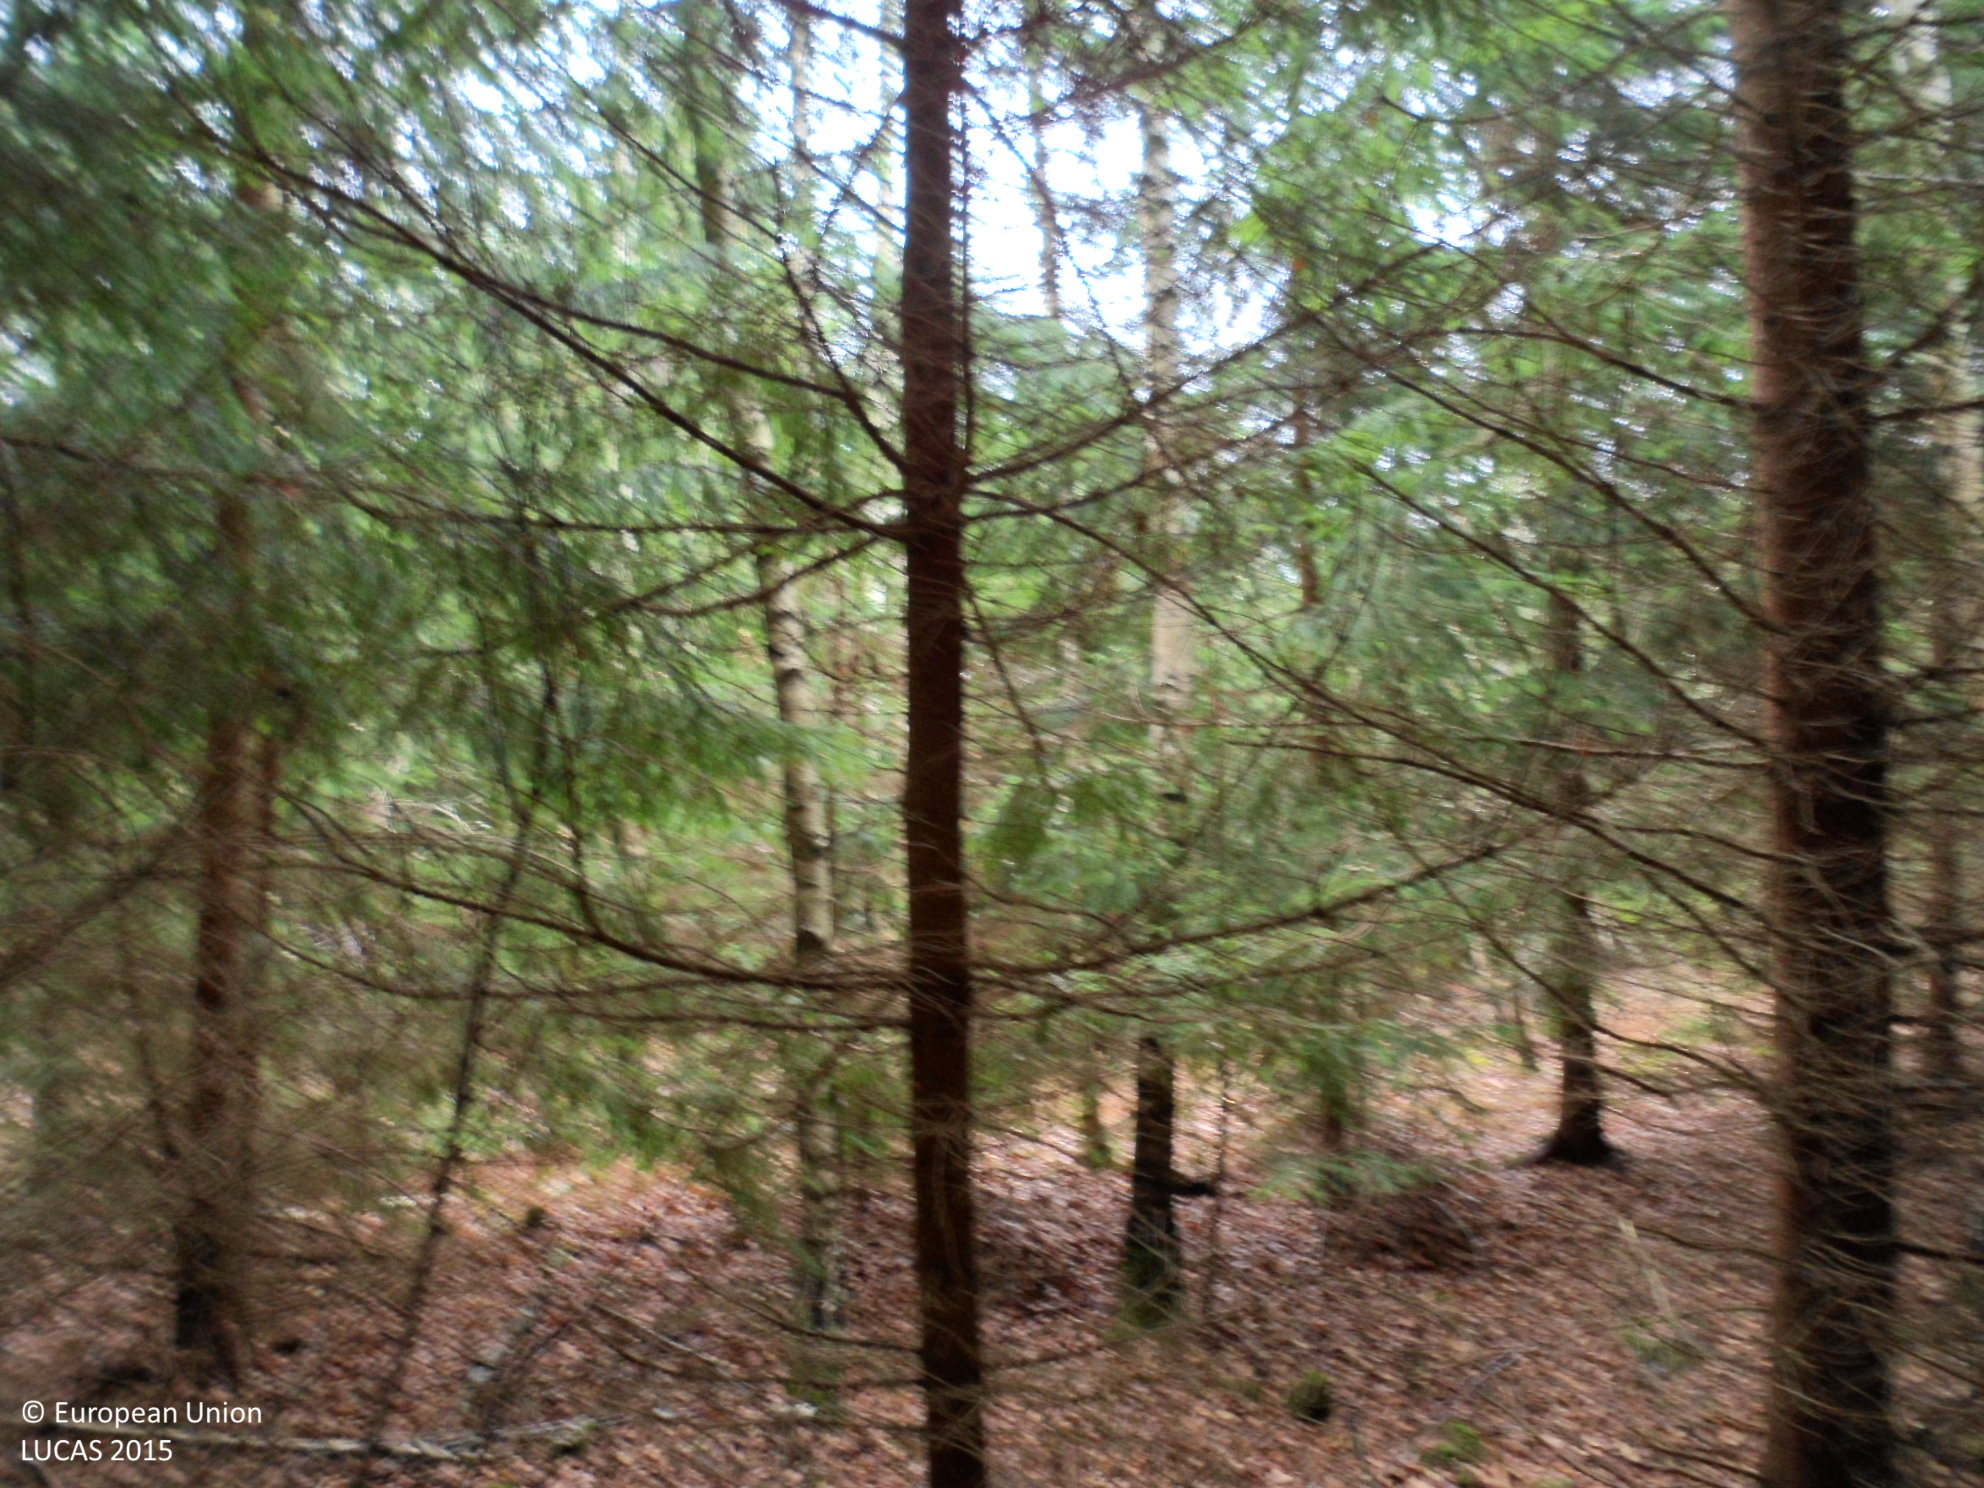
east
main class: Woodland
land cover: Spruce dominated coniferous woodland
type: boreal forest
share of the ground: > 75 %
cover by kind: coniferous forest trees 75 %, unconsolidated bare surface 15 %, broadleaved forest trees 5 %, lichens and mosses 5 %
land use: Forestry
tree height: > 5 m
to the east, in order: Spruce dominated coniferous woodland; Spruce dominated mixed woodland; Ditches and canals; Spruce dominated mixed woodland; Dry stone walls; Spruce dominated coniferous woodland; Ditches and canals; Paved roads, cycling and walking lanes; Grass margins; Pine dominated coniferous woodland; Spruce dominated mixed woodland
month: November
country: SE
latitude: 56.7925
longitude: 15.8766
